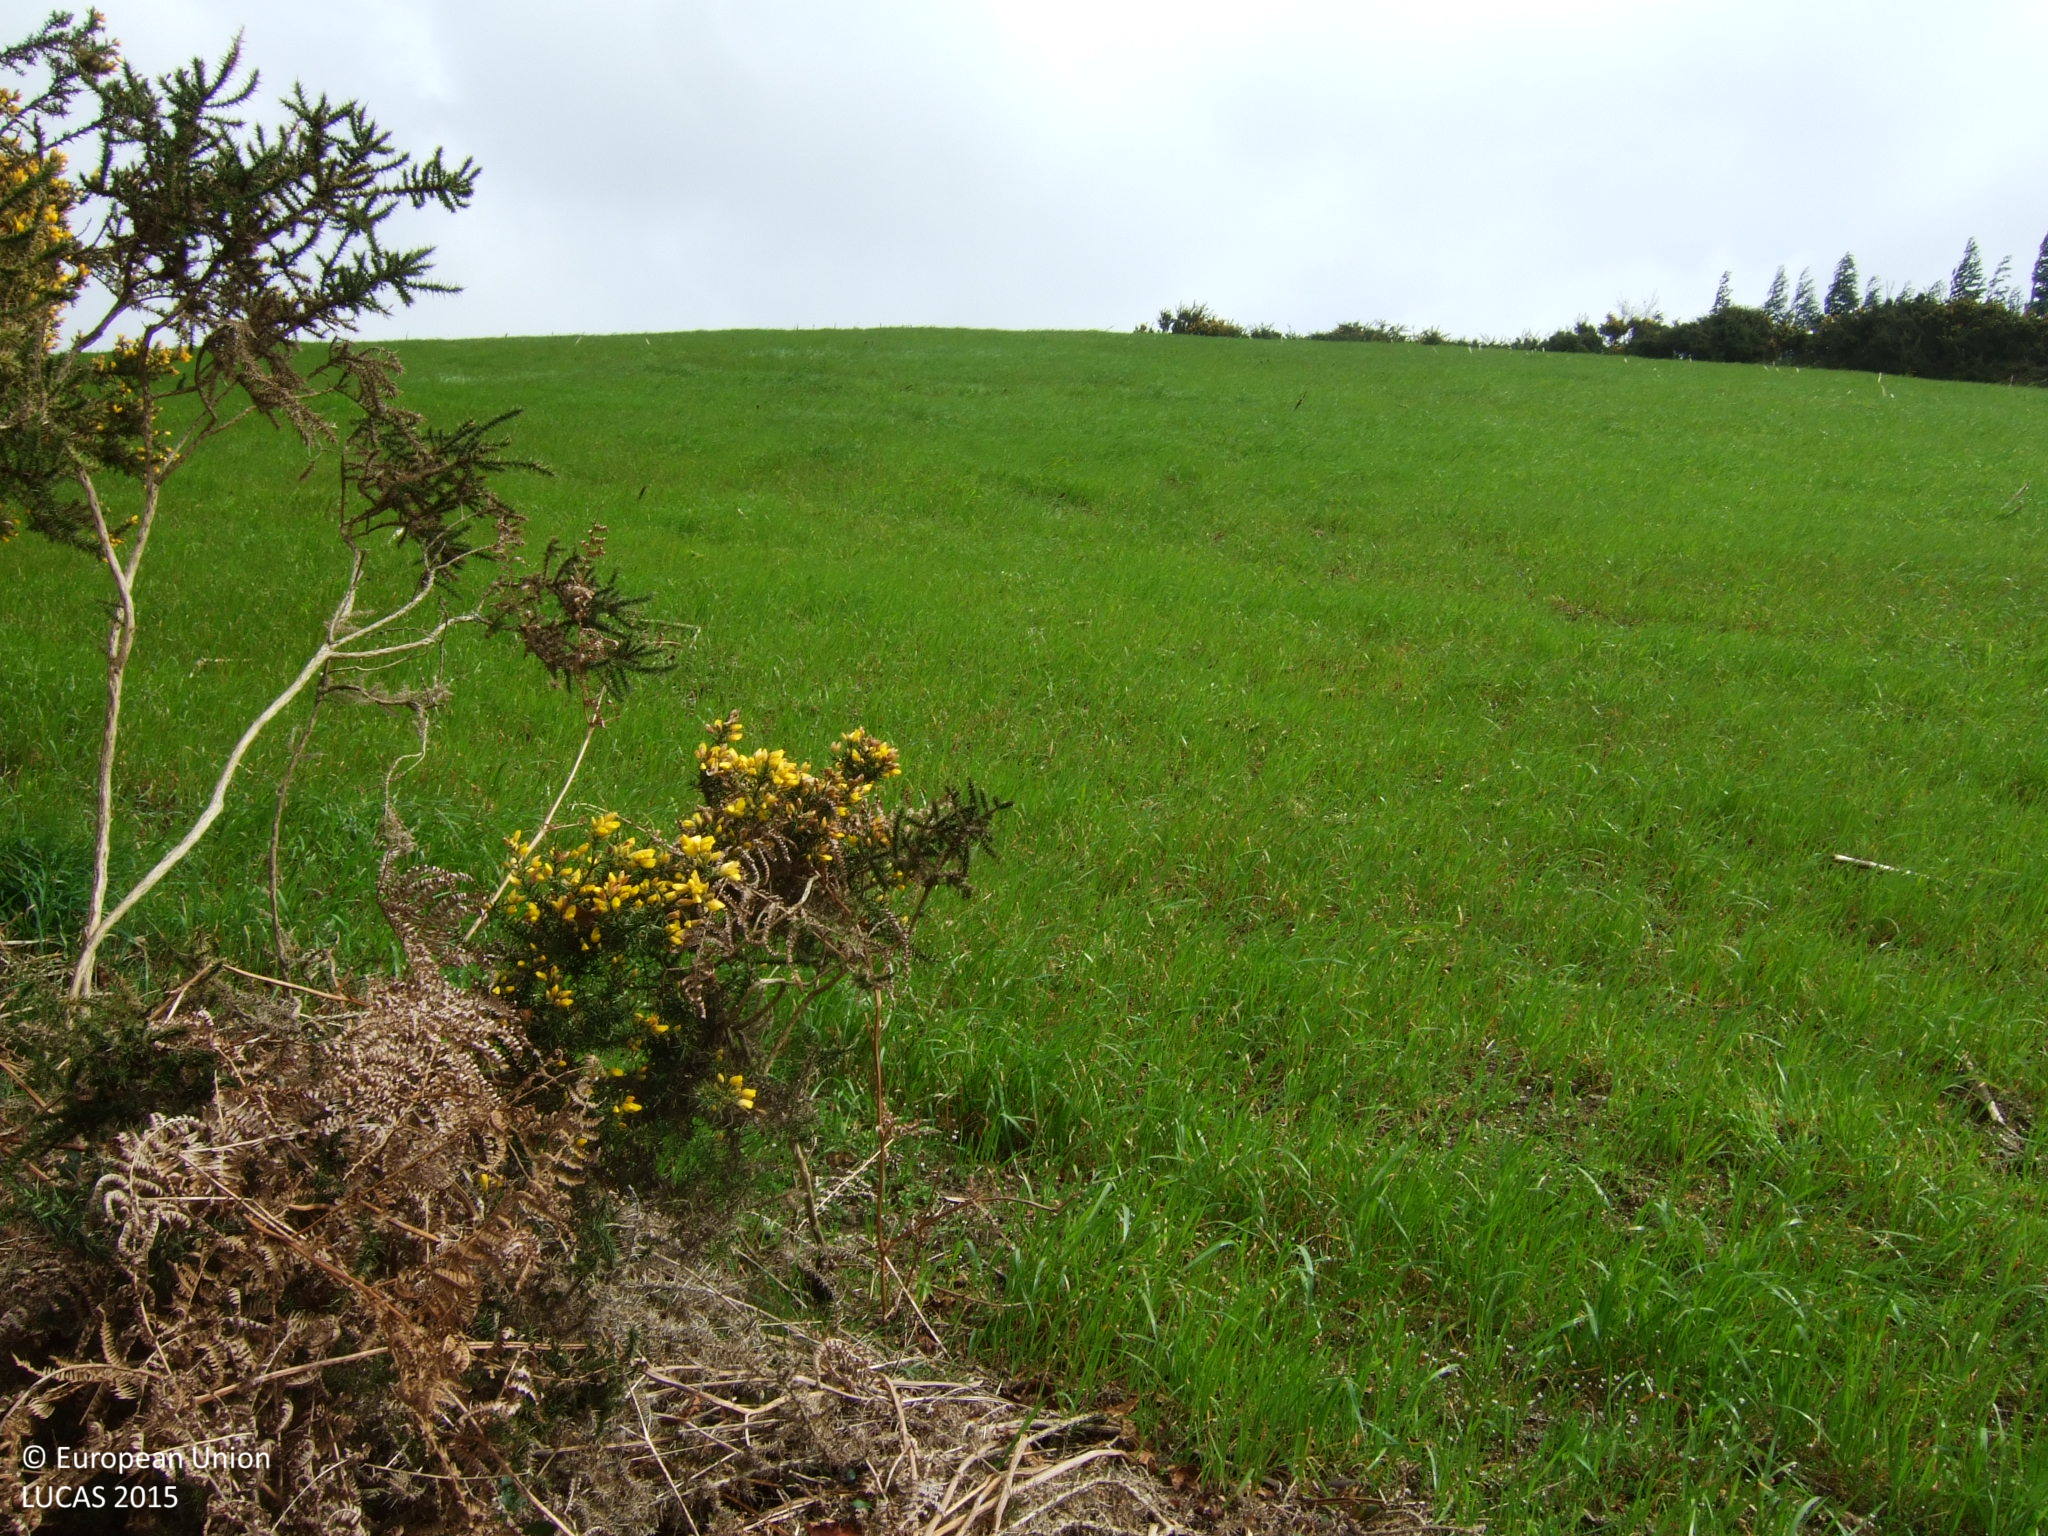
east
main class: Woodland
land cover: Broadleaved woodland
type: acidophilous oak and oak-birch forest
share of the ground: > 75 %
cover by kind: broadleaved forest trees 80 %, shrubs 20 %
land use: Semi-natural and natural areas not in use
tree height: > 5 m
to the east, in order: Broadleaved woodland; Shrubland with sparse tree cover; Grassland without tree/shrub cover
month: March
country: ES
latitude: 42.9323
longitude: -7.8645
